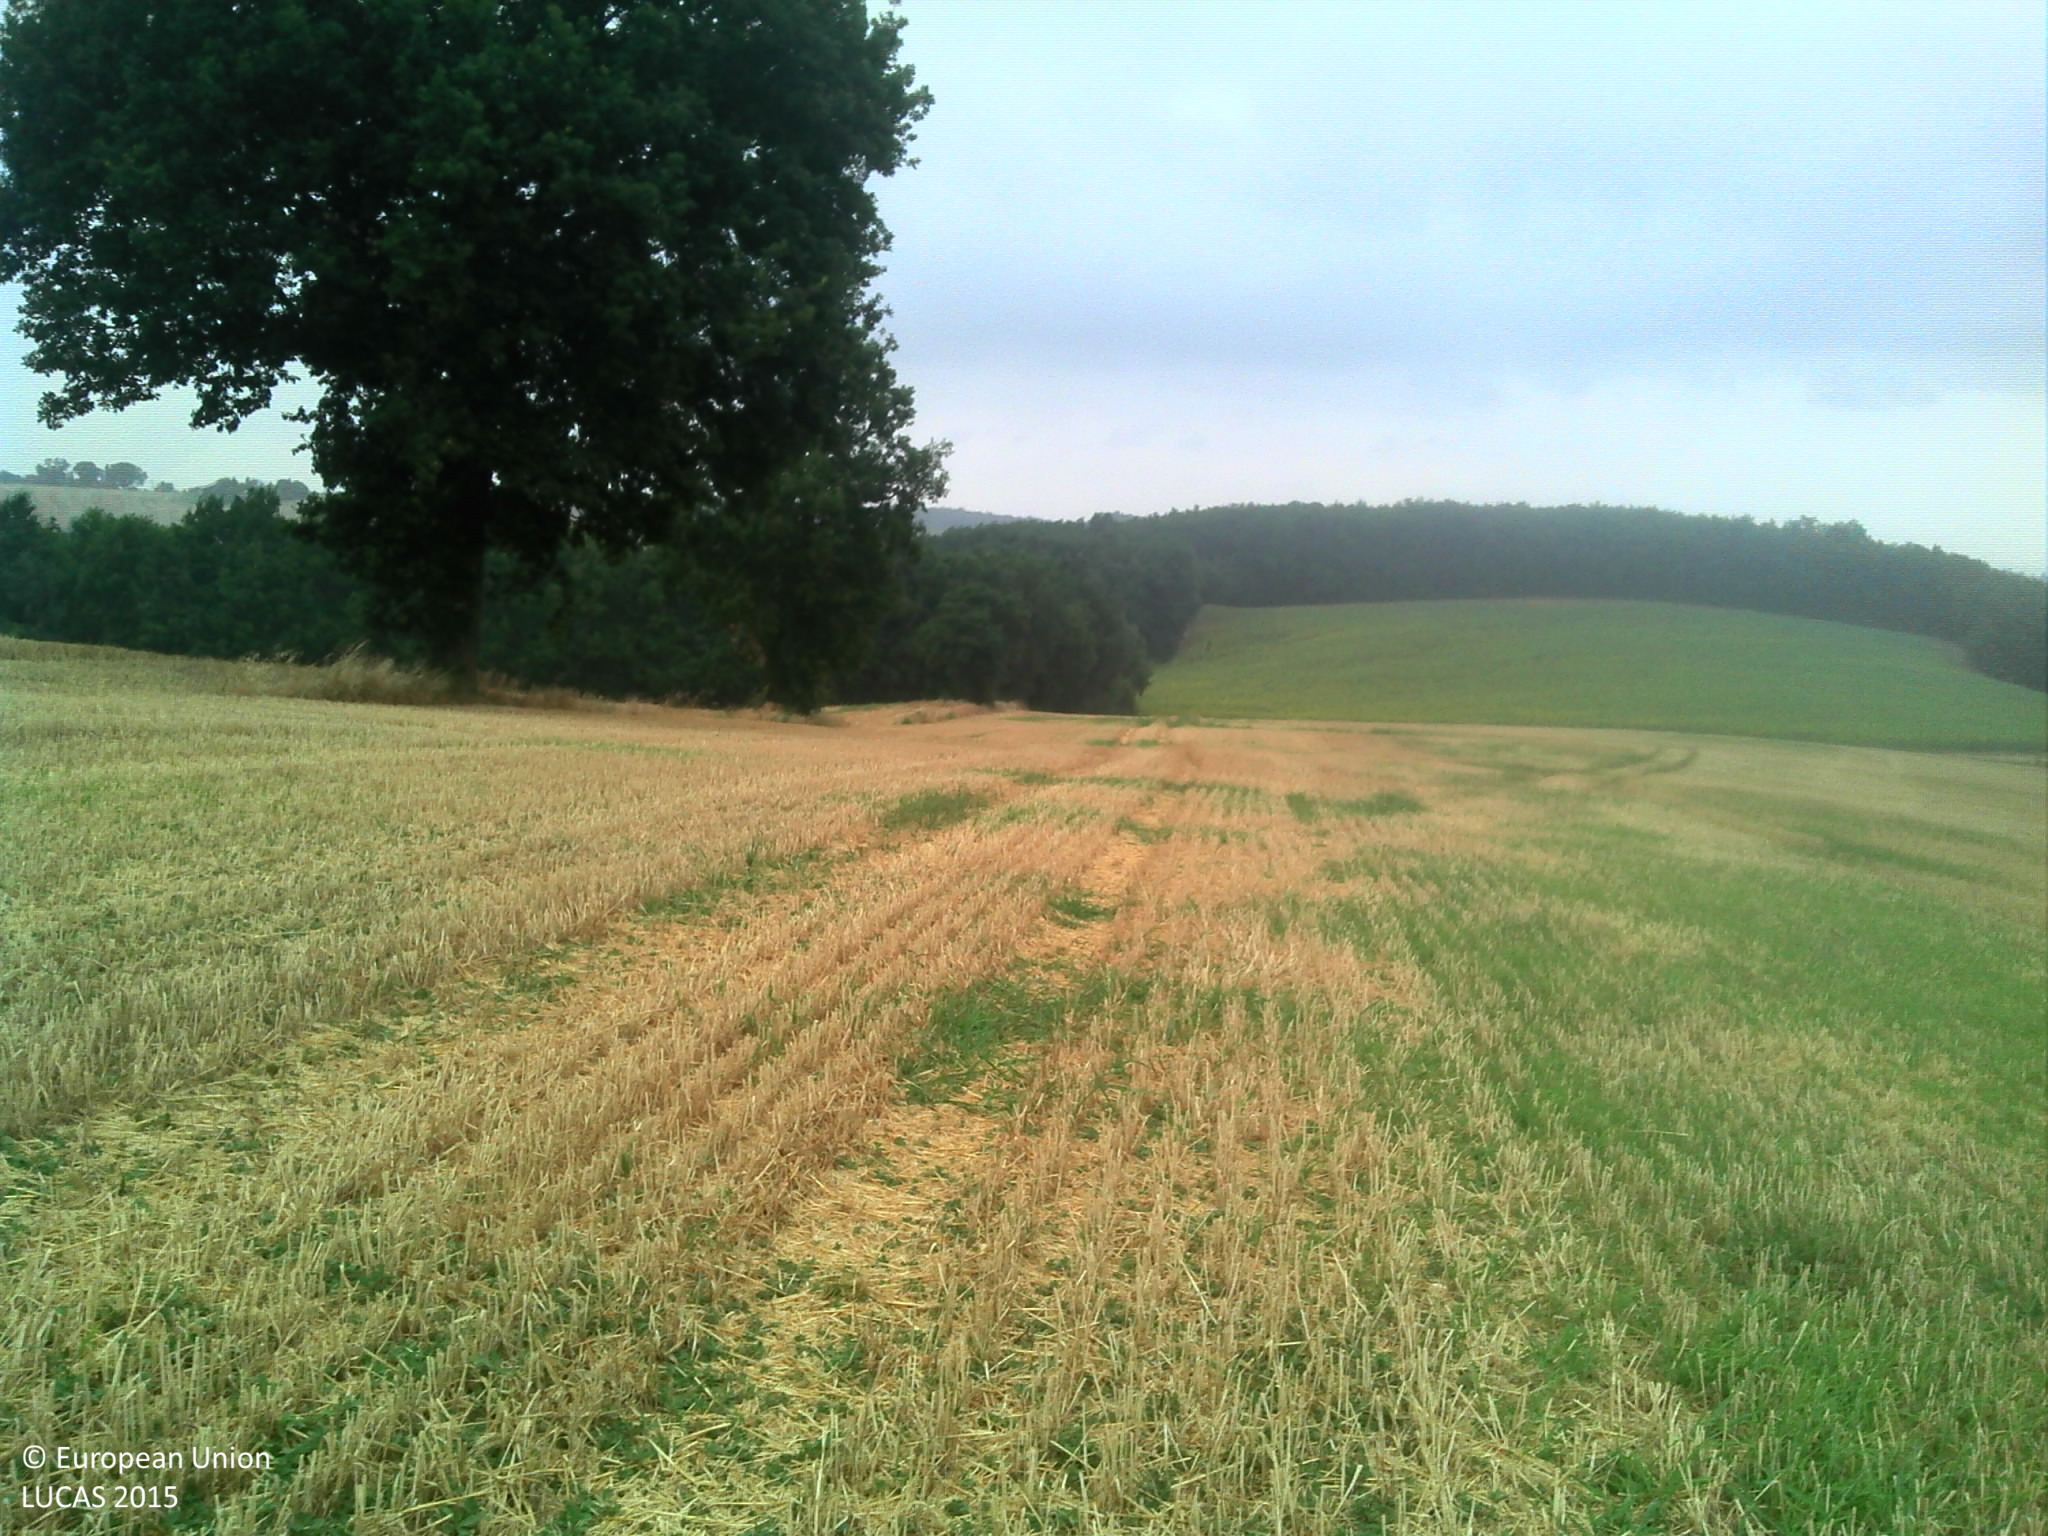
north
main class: Cropland
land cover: Common wheat
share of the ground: > 75 %
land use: Agriculture (excluding fallow land and kitchen gardens)
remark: Harvested field
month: July
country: FR
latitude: 43.9670
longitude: 0.8865
